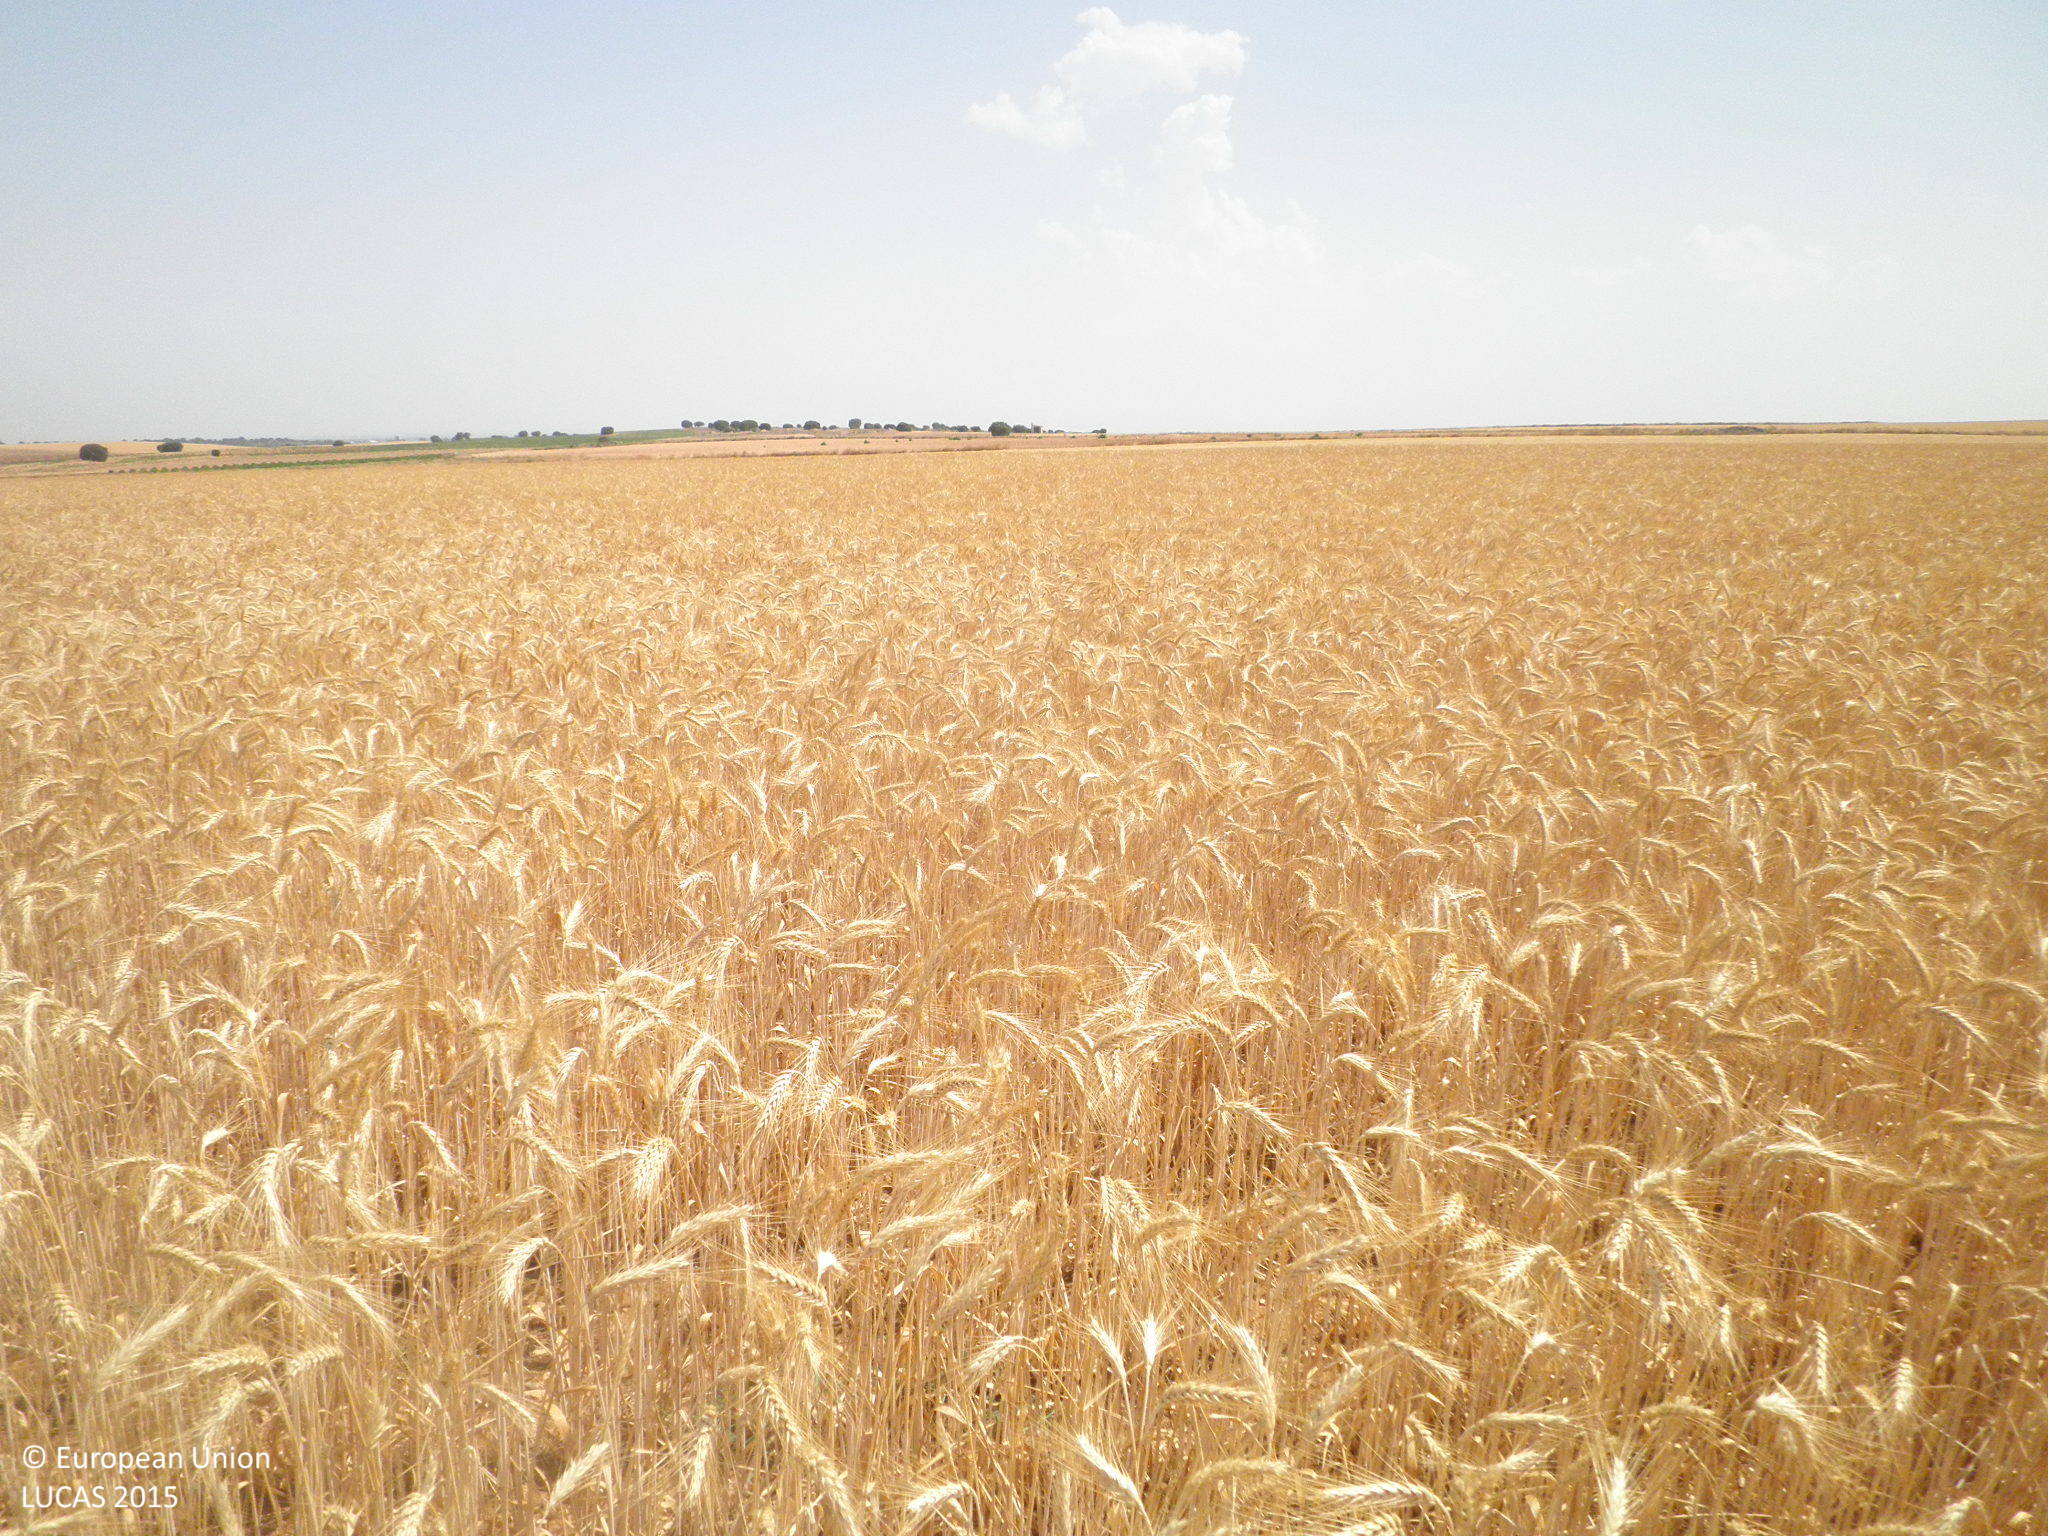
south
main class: Cropland
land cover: Durum wheat
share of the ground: > 75 %
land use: Agriculture (excluding fallow land and kitchen gardens)
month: July
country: ES
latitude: 39.4696
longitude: -2.6014
